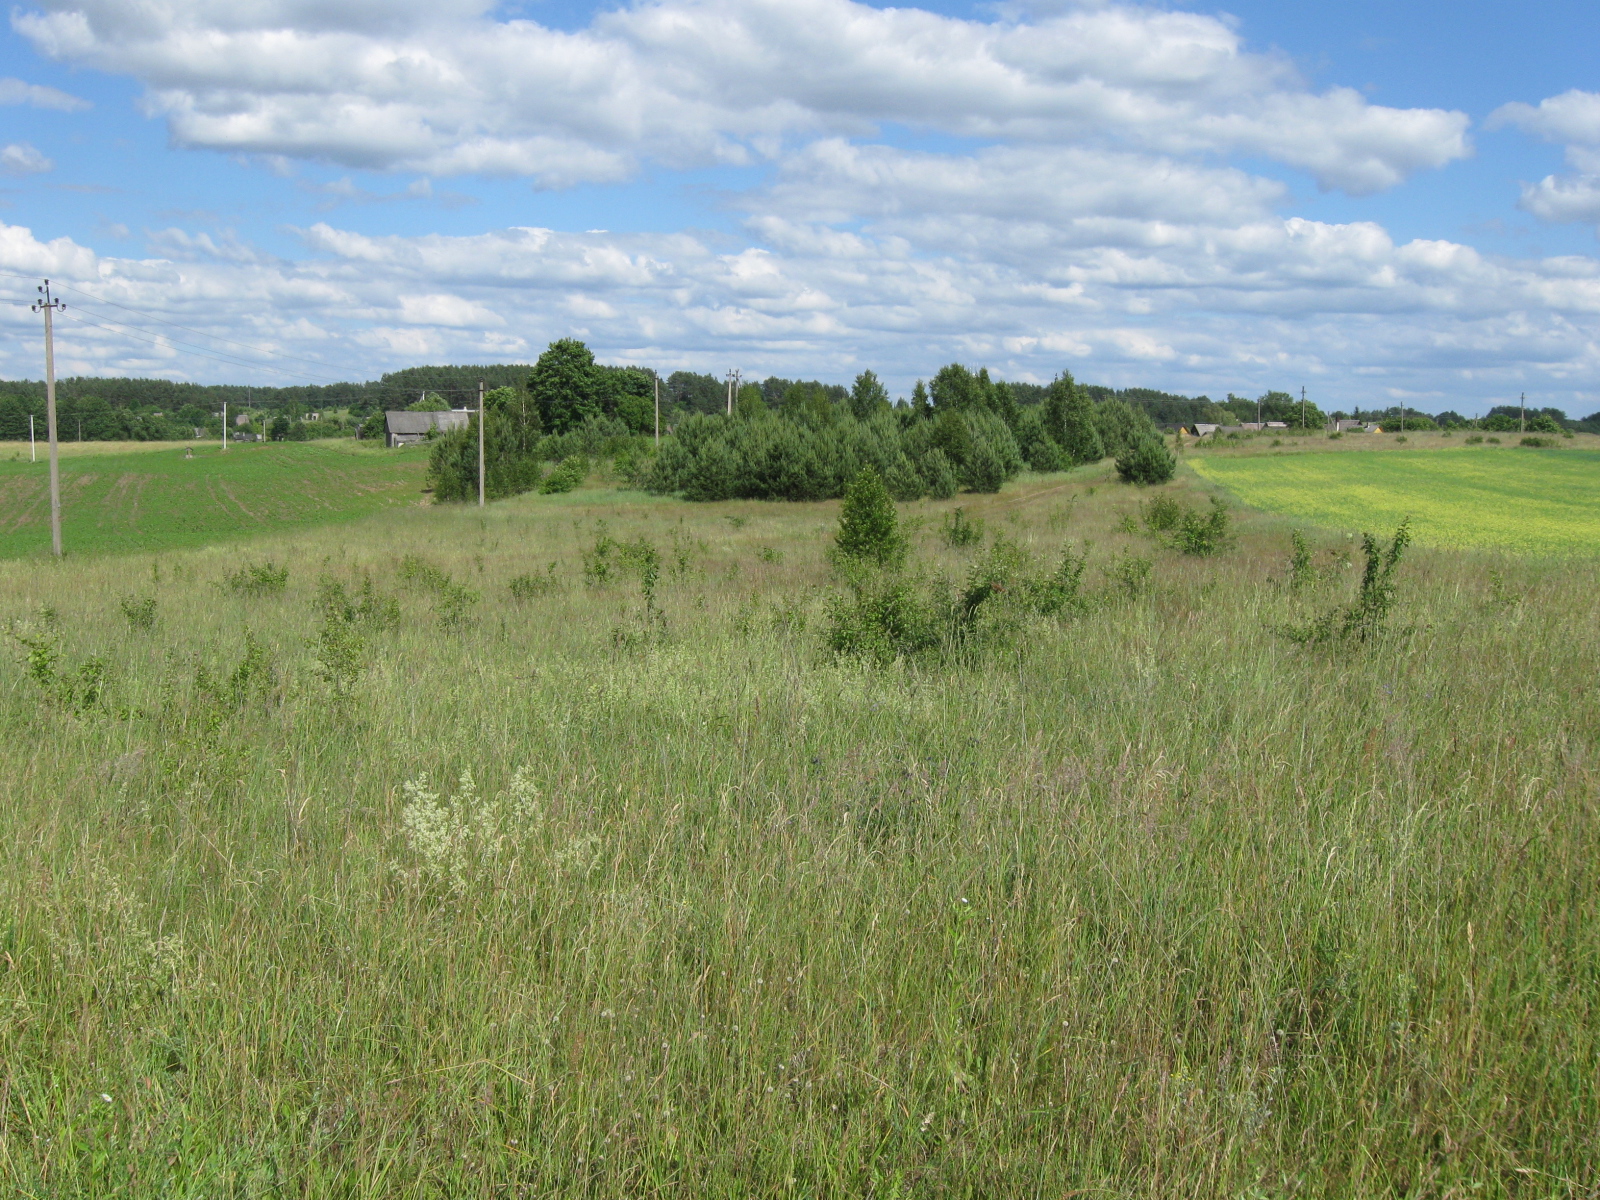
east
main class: Grassland
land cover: Grassland with sparse tree/shrub cover
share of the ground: > 75 %
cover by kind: herbaceous plants 95 %, broadleaved forest trees 5 %
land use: Agriculture (excluding fallow land and kitchen gardens)
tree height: < 5 m
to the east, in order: Grassland with sparse tree/shrub cover; Tracks; Grassland with sparse tree/shrub cover; Pine dominated mixed woodland; Grassland with sparse tree/shrub cover; Other cereals; Electric lines; Other cereals
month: June
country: LT
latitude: 54.4964
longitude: 24.6668
